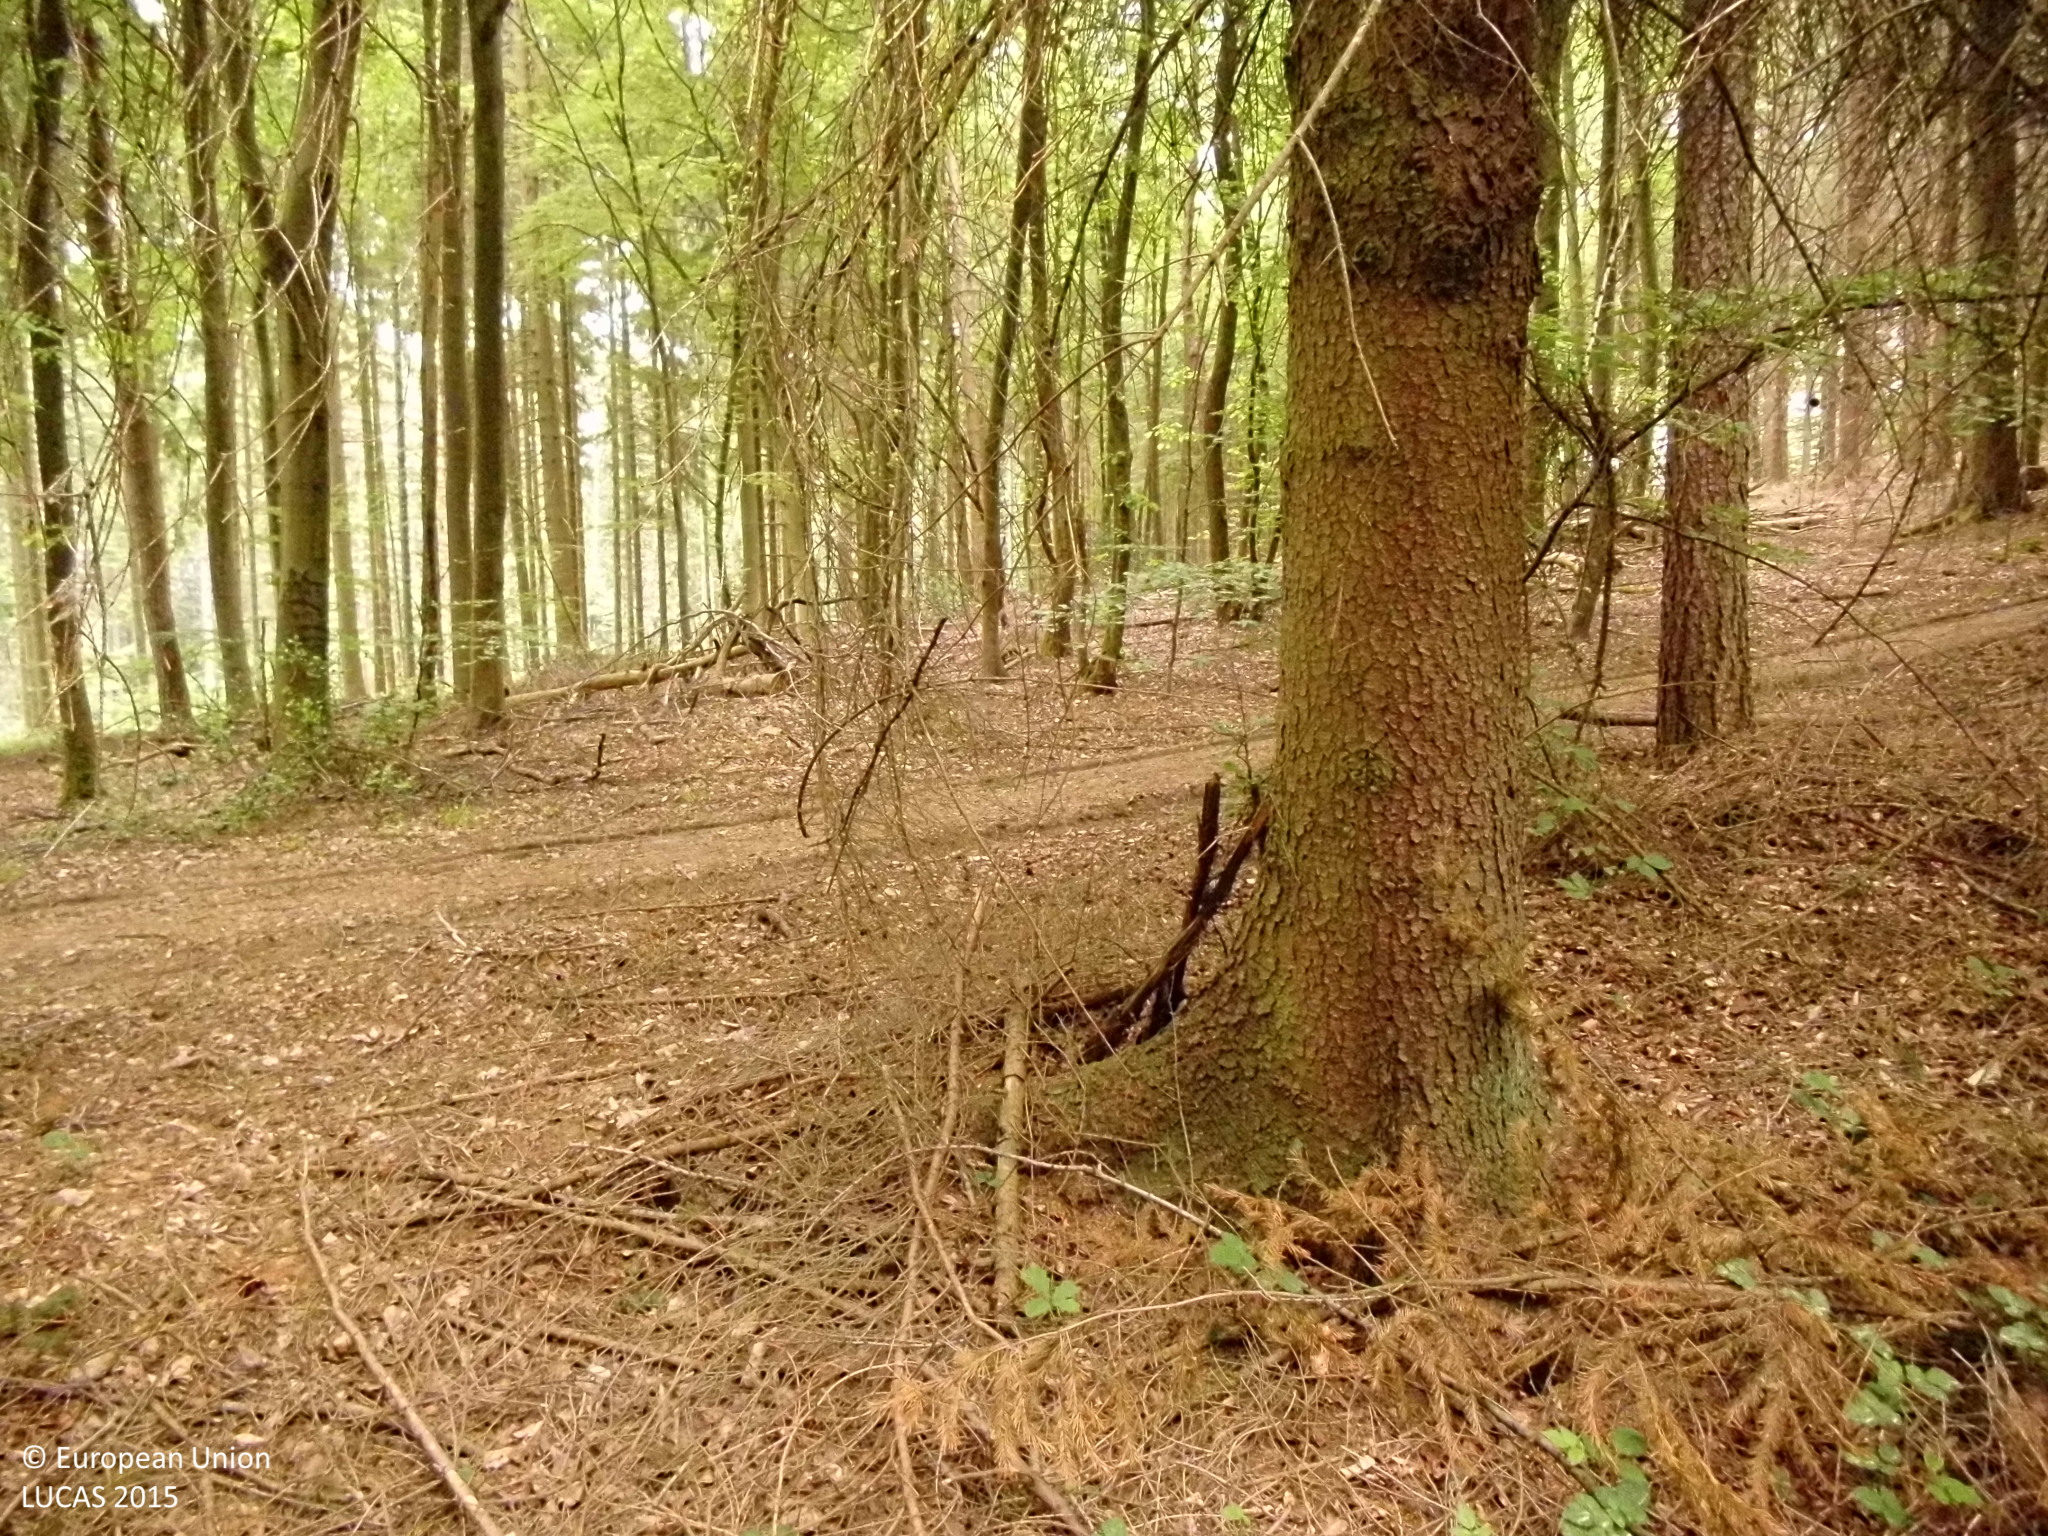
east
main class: Woodland
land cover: Other mixed woodland
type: hemiboreal forest and nemoral coniferous forest and mixed broadleaved-coniferous forest
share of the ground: > 75 %
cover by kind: coniferous forest trees 60 %, broadleaved forest trees 25 %, herbaceous plants 10 %, lichens and mosses 5 %
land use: Forestry
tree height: > 5 m
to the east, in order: Other mixed woodland; Tracks; Other mixed woodland; Pine dominated mixed woodland; Spruce dominated coniferous woodland; Tracks; Broadleaved woodland; Ditches and canals; Spruce dominated coniferous woodland; Broadleaved woodland
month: May
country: DE
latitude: 50.7503
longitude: 7.4915
